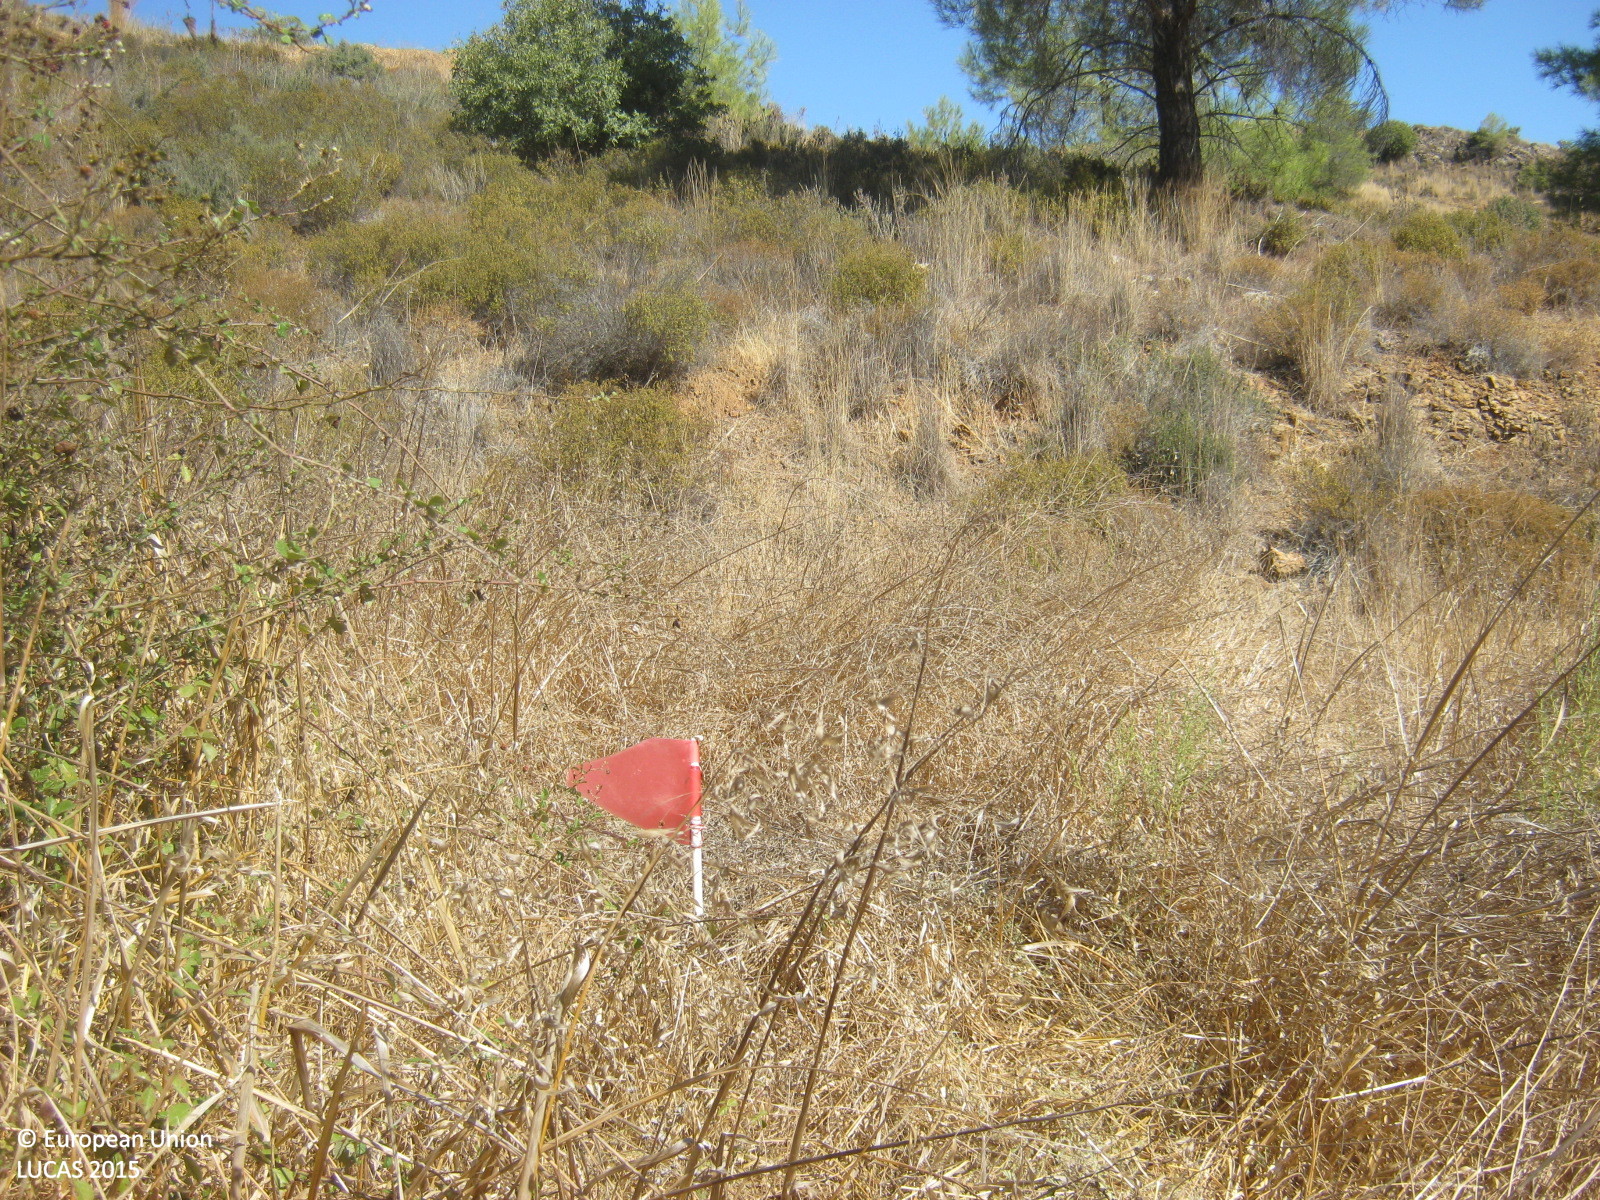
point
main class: Shrubland
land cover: Shrubland without tree cover
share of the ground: 50 - 75 %
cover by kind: shrubs 50 %, unconsolidated bare surface 30 %, herbaceous plants 20 %
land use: Semi-natural and natural areas not in use
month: April
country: CY
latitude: 34.9435
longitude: 33.3661
